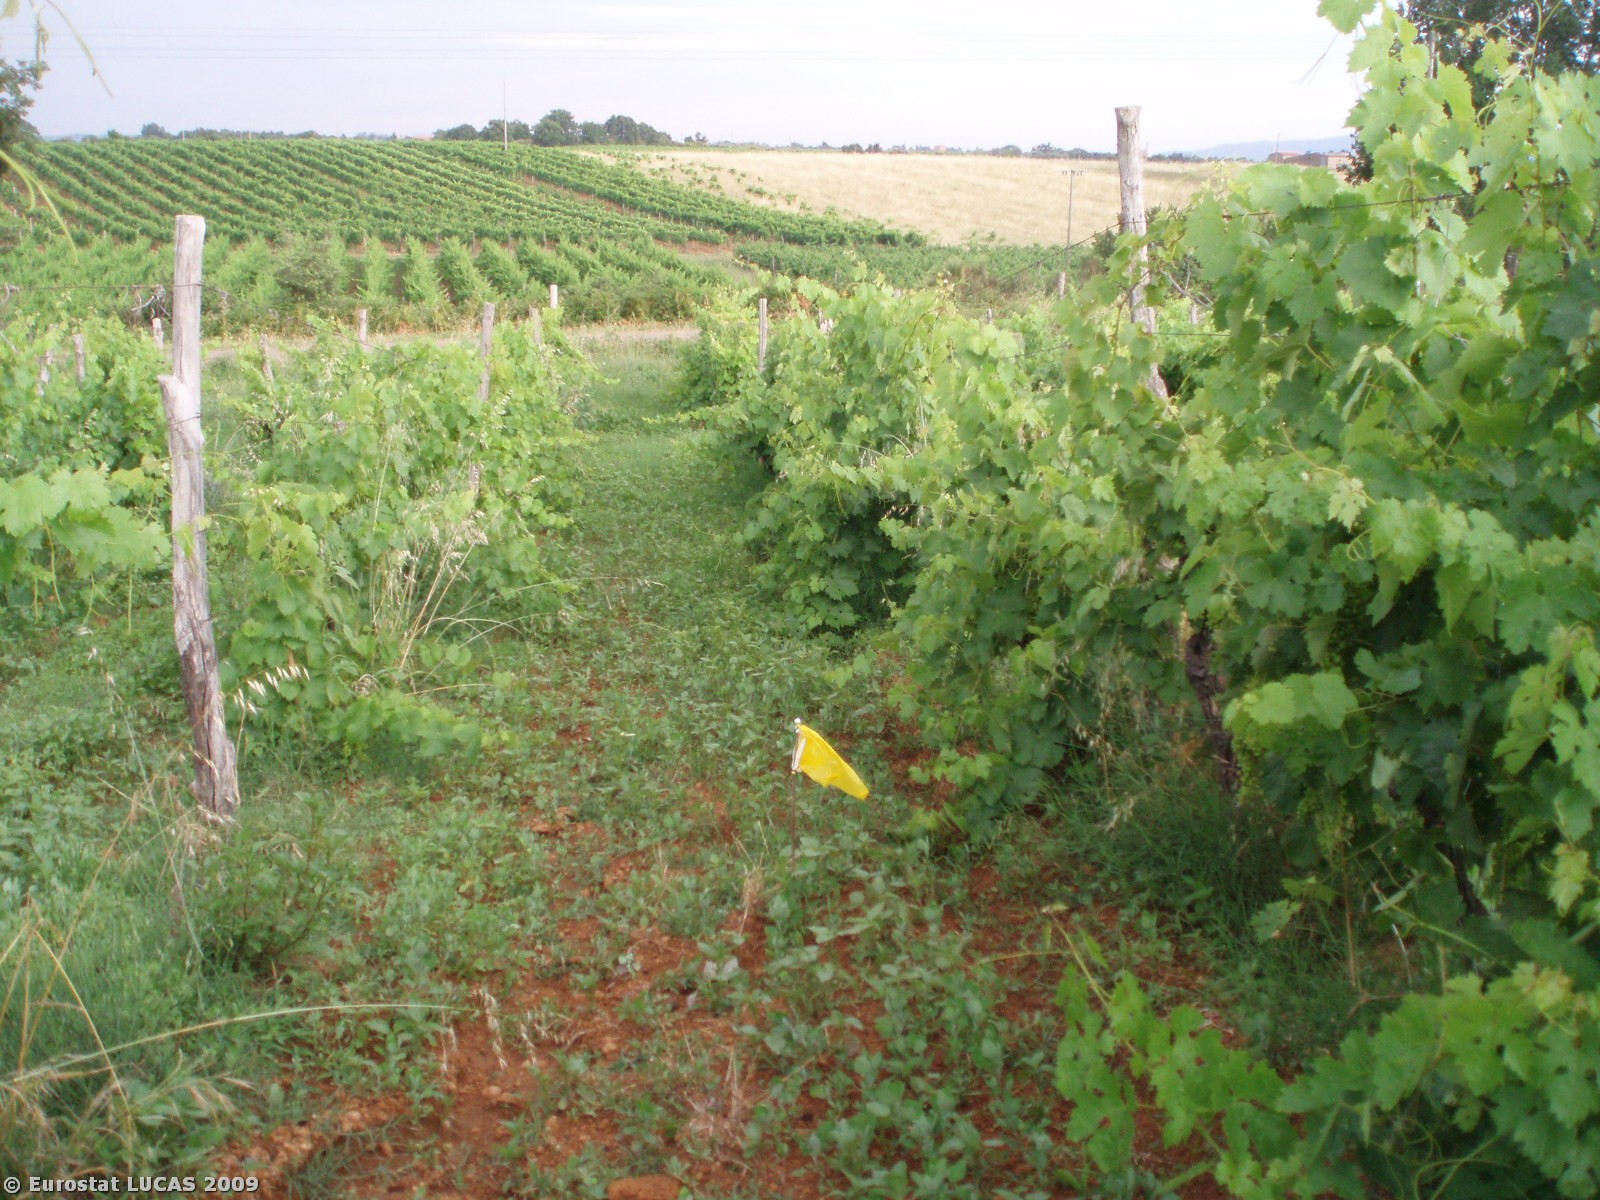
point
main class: Cropland
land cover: Vineyards
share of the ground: 50 - 75 %
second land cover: Spontaneously vegetated surfaces
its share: 50 - 75 %
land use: Agriculture (excluding fallow land and kitchen gardens)
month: June
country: IT
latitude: 42.6231
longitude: 11.6162
